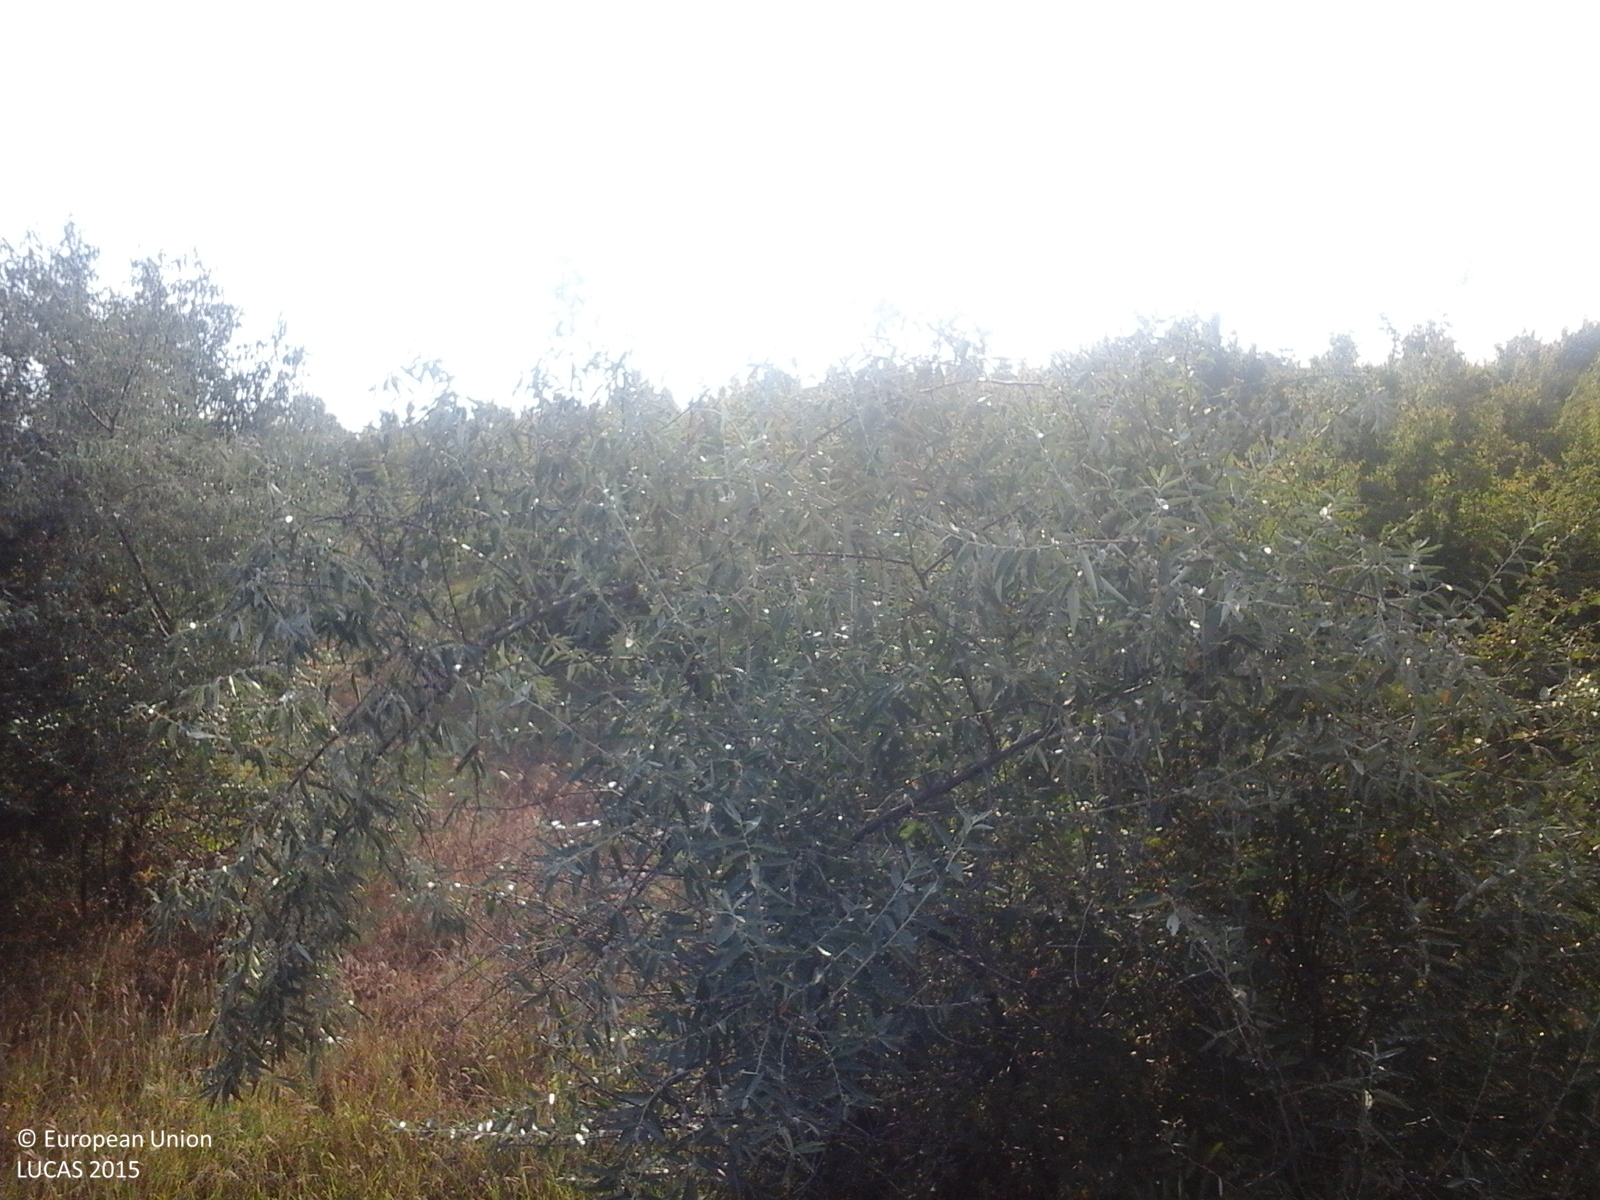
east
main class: Grassland
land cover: Grassland with sparse tree/shrub cover
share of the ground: > 75 %
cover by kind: herbaceous plants 95 %, broadleaved forest trees 5 %
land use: Semi-natural and natural areas not in use
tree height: > 5 m
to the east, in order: Grassland with sparse tree/shrub cover; Broadleaved woodland; Grassland with sparse tree/shrub cover
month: August
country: RO
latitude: 44.0579
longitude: 27.9648
